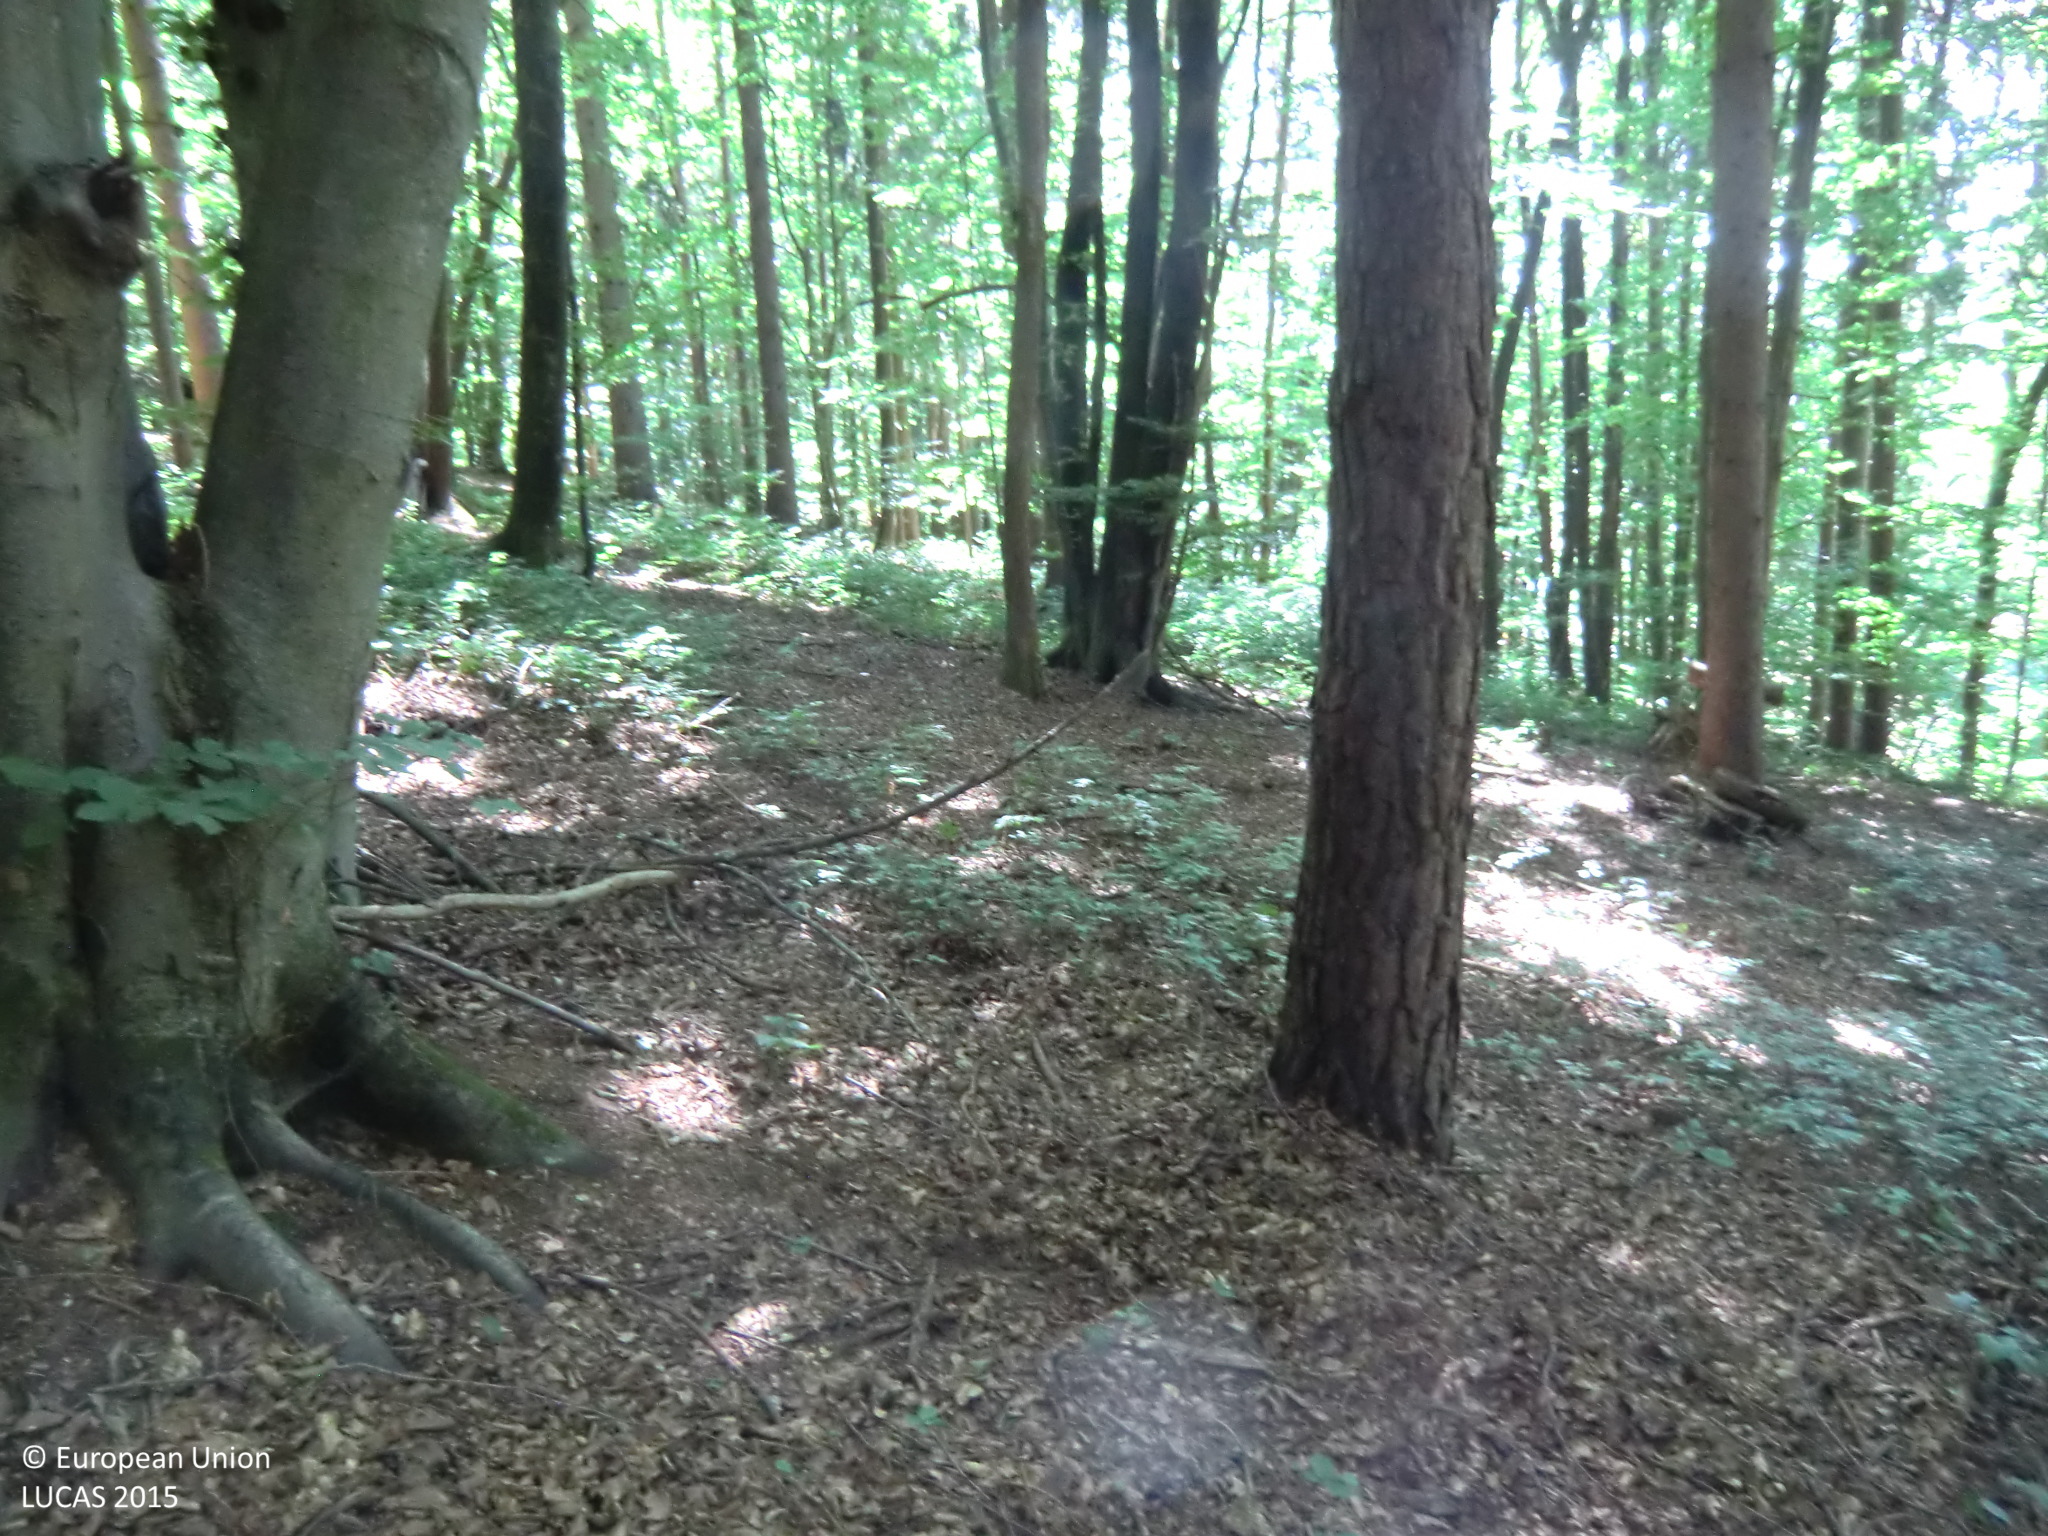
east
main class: Woodland
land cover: Spruce dominated mixed woodland
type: hemiboreal forest and nemoral coniferous forest and mixed broadleaved-coniferous forest
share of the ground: > 75 %
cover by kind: coniferous forest trees 45 %, broadleaved forest trees 40 %, unconsolidated bare surface 10 %, herbaceous plants 5 %
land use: Forestry
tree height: > 5 m
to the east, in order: Spruce dominated mixed woodland; Electric lines; Spruce dominated mixed woodland; Broadleaved woodland; Grassland with sparse tree/shrub cover; Artificial constructions in urban areas; Grass margins; Pine dominated mixed woodland
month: July
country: AT
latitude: 47.0352
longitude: 15.5930
